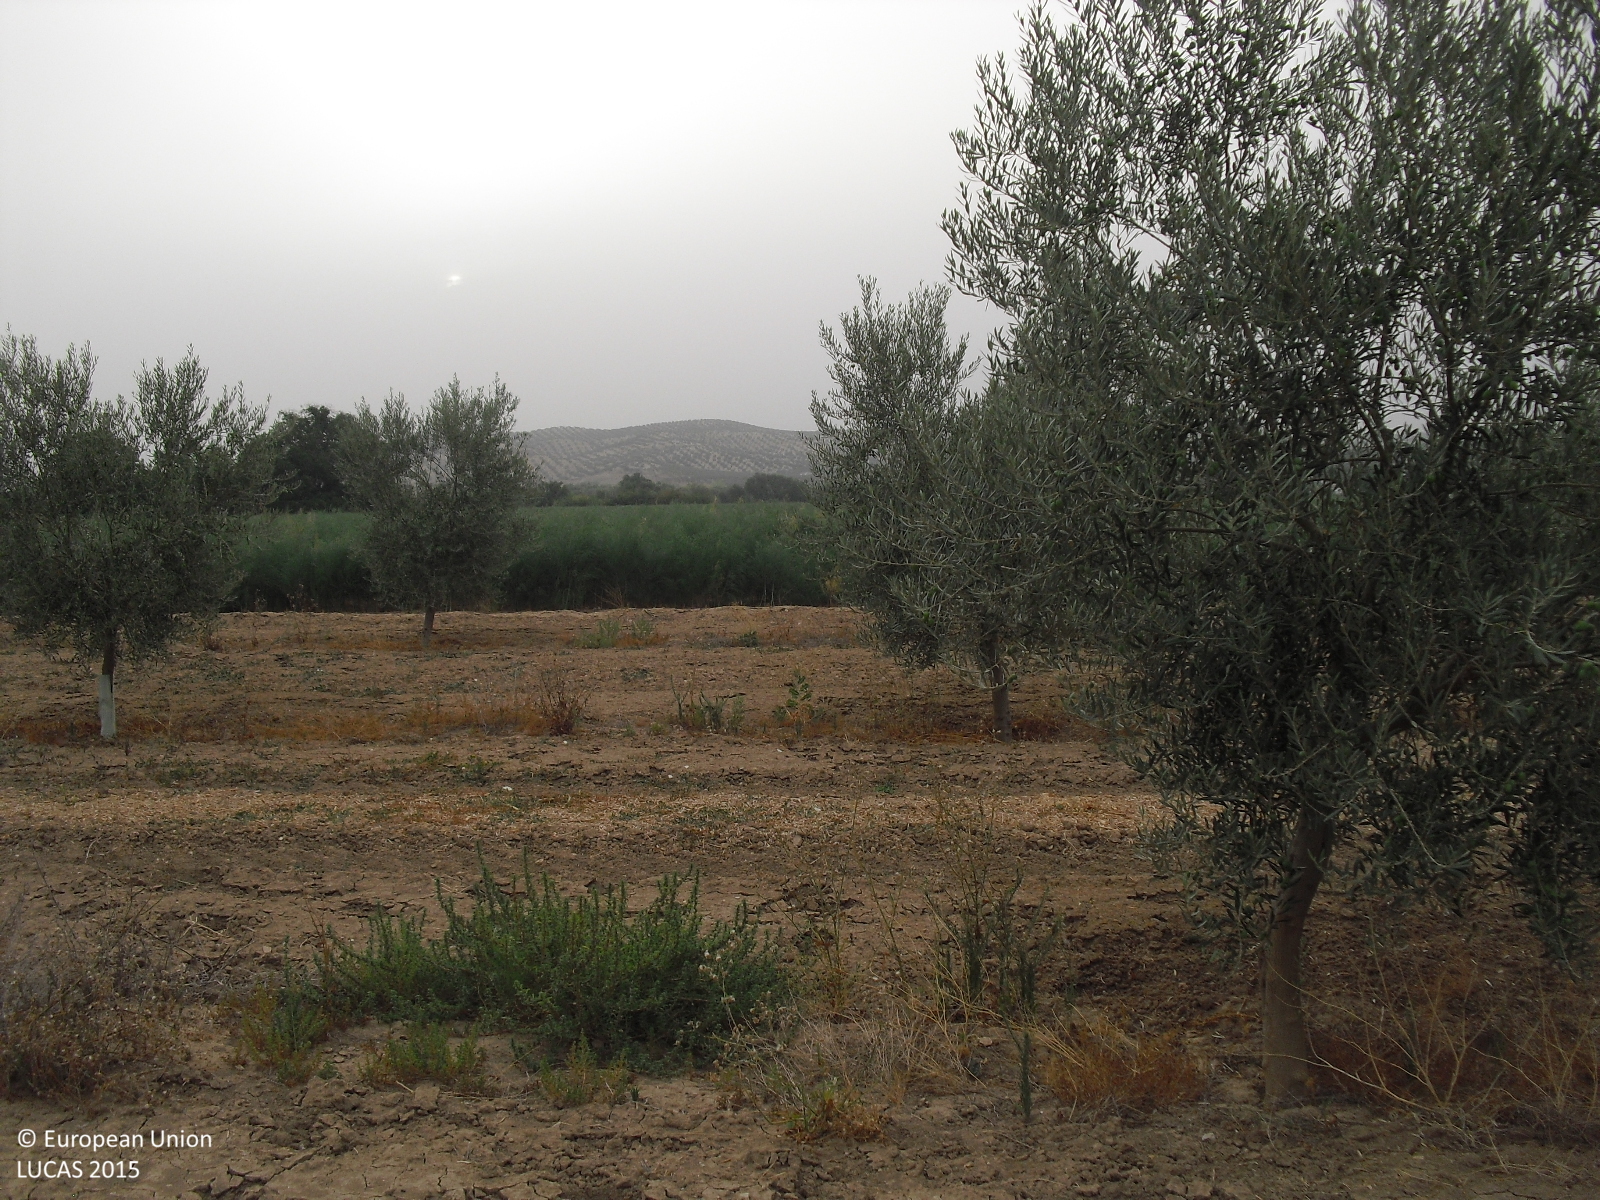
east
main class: Cropland
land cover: Olive groves
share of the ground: < 10 %
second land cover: Spontaneously vegetated surfaces
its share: 10 - 25 %
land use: Agriculture (excluding fallow land and kitchen gardens)
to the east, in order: Olive groves; Spontaneously vegetated surfaces; Other fresh vegetables; Tracks; Other fresh vegetables; Other bare soil; Fences; Other fresh vegetables; Fences; Lucerne; Grass margins; Other fresh vegetables
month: August
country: ES
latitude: 37.1683
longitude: -4.1053
